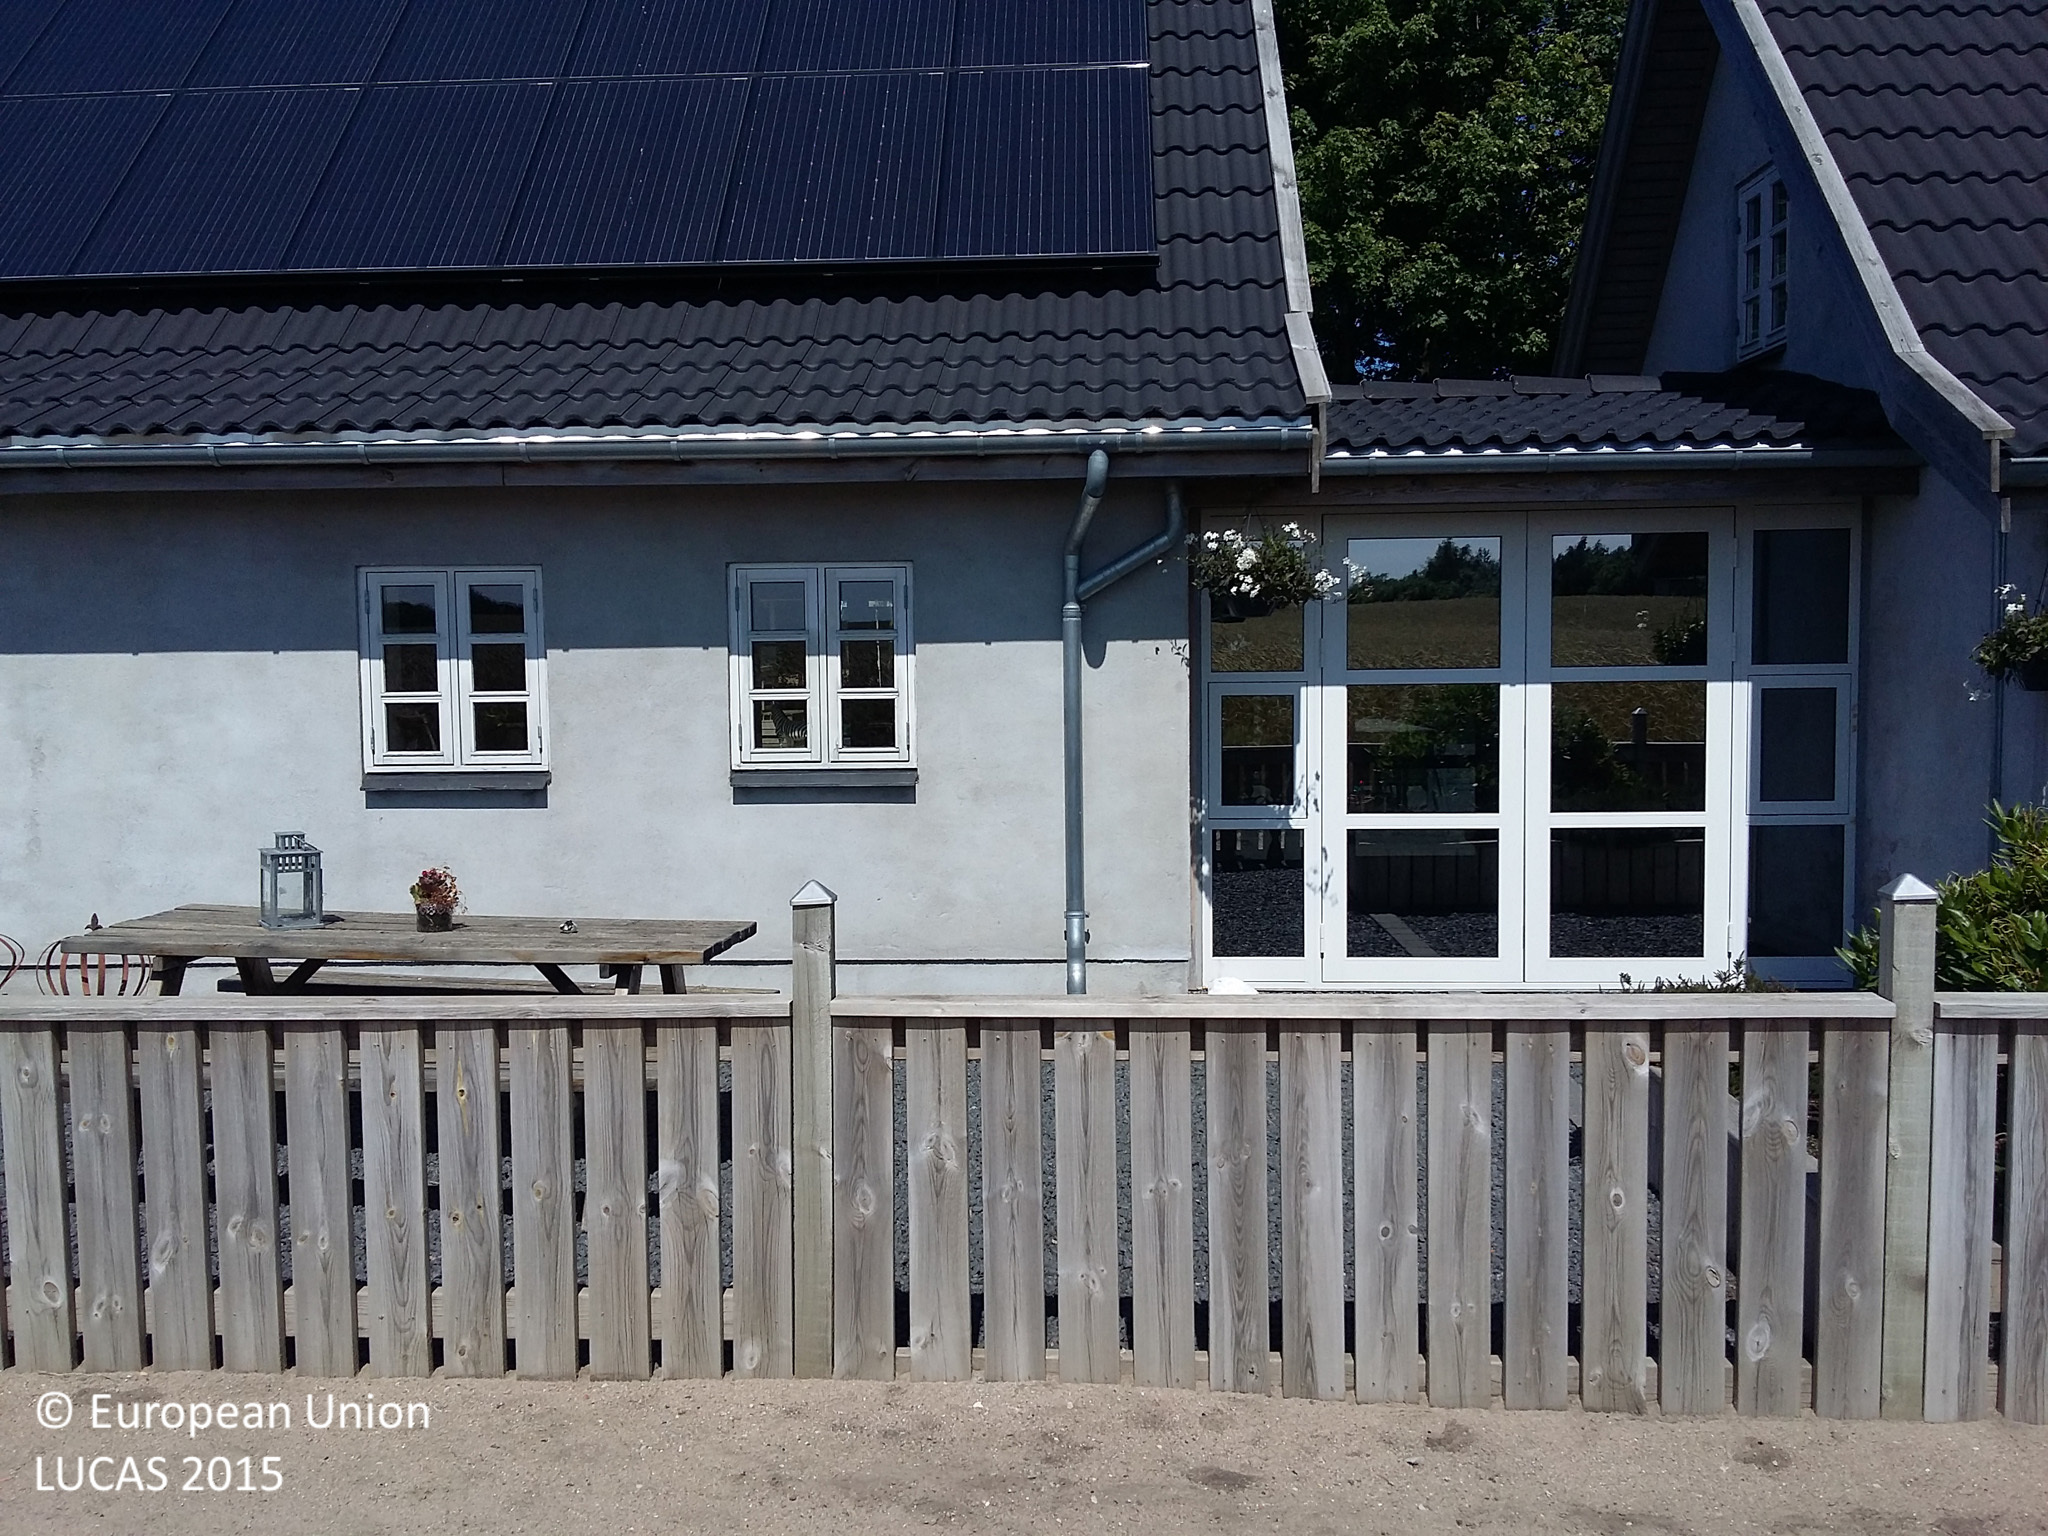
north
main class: Cropland
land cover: Rye
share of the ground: > 75 %
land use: Agriculture (excluding fallow land and kitchen gardens)
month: July
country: DK
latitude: 55.5677
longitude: 11.5051
